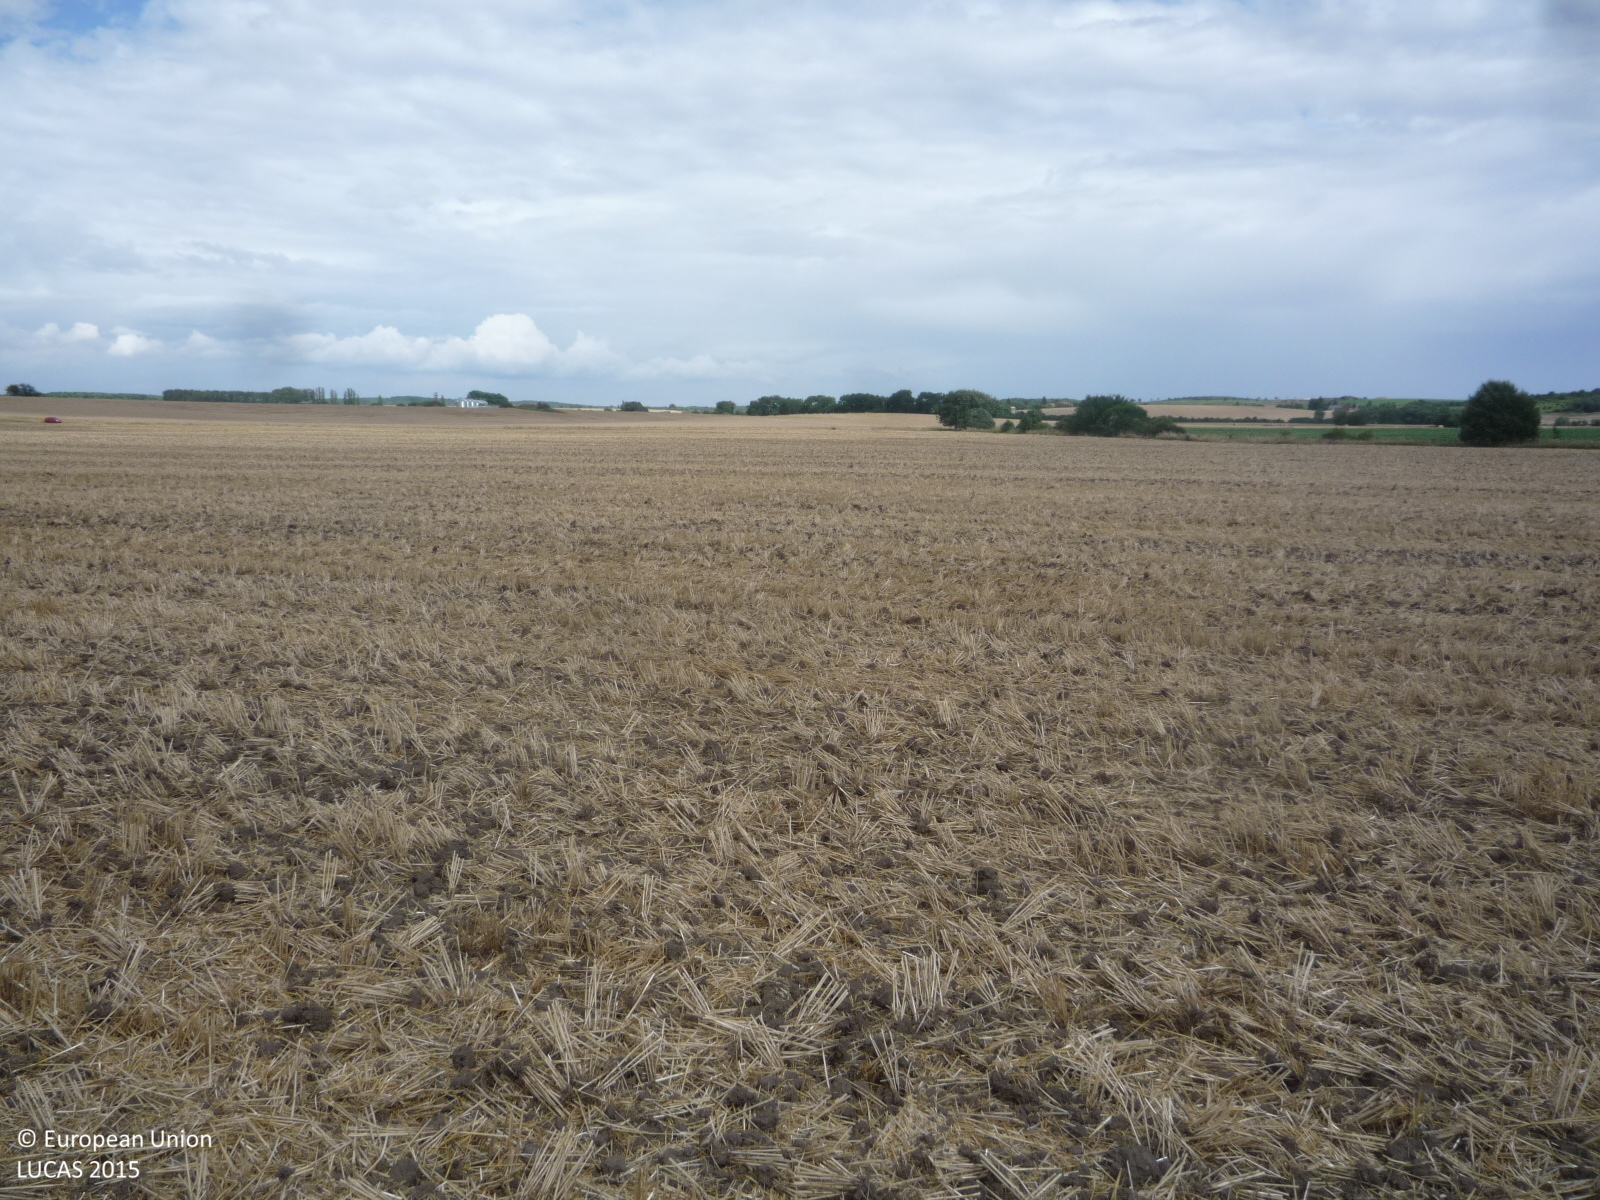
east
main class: Cropland
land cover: Common wheat
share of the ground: > 75 %
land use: Agriculture (excluding fallow land and kitchen gardens)
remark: Tilled/Sowed
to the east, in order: Common wheat
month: July
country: CZ
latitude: 50.3147
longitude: 15.2697
